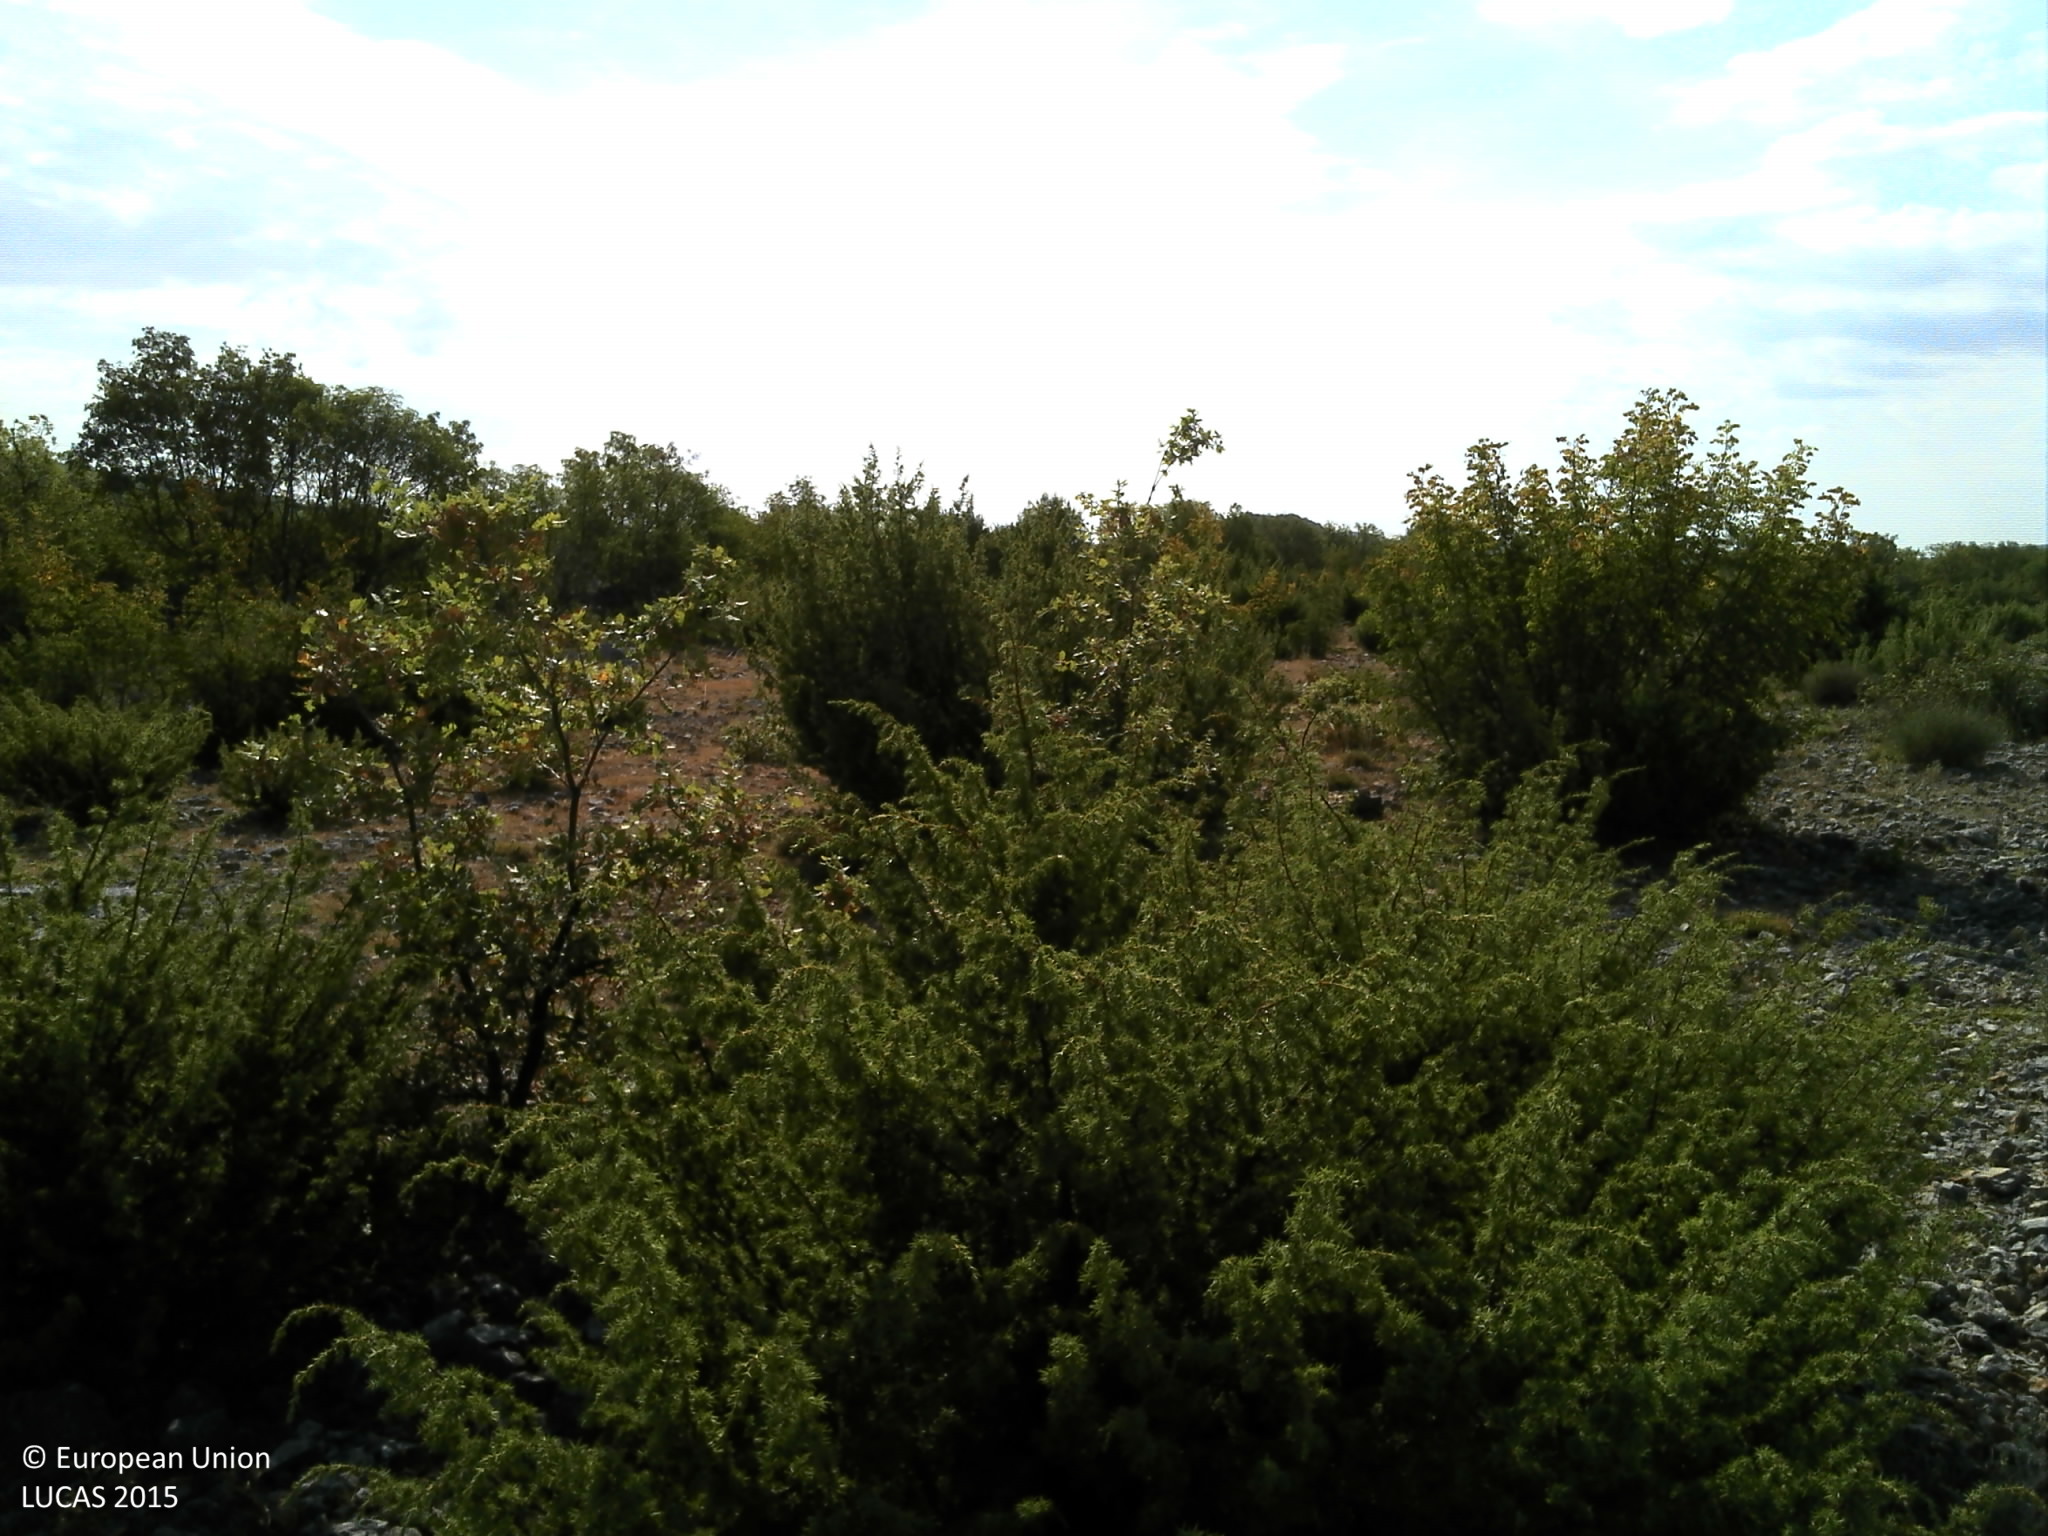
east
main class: Shrubland
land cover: Shrubland without tree cover
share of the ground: 25 - 50 %
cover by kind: unconsolidated bare surface 45 %, shrubs 30 %, herbaceous plants 15 %, consolidated bare surface 10 %
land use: Semi-natural and natural areas not in use
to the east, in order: Shrubland without tree cover; Shrubland with sparse tree cover; Dry stone walls; Shrubland with sparse tree cover; Electric lines; Shrubland with sparse tree cover; Dry stone walls; Shrubland with sparse tree cover; Dry stone walls; Shrubland with sparse tree cover
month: July
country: HR
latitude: 43.7737
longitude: 16.0914
